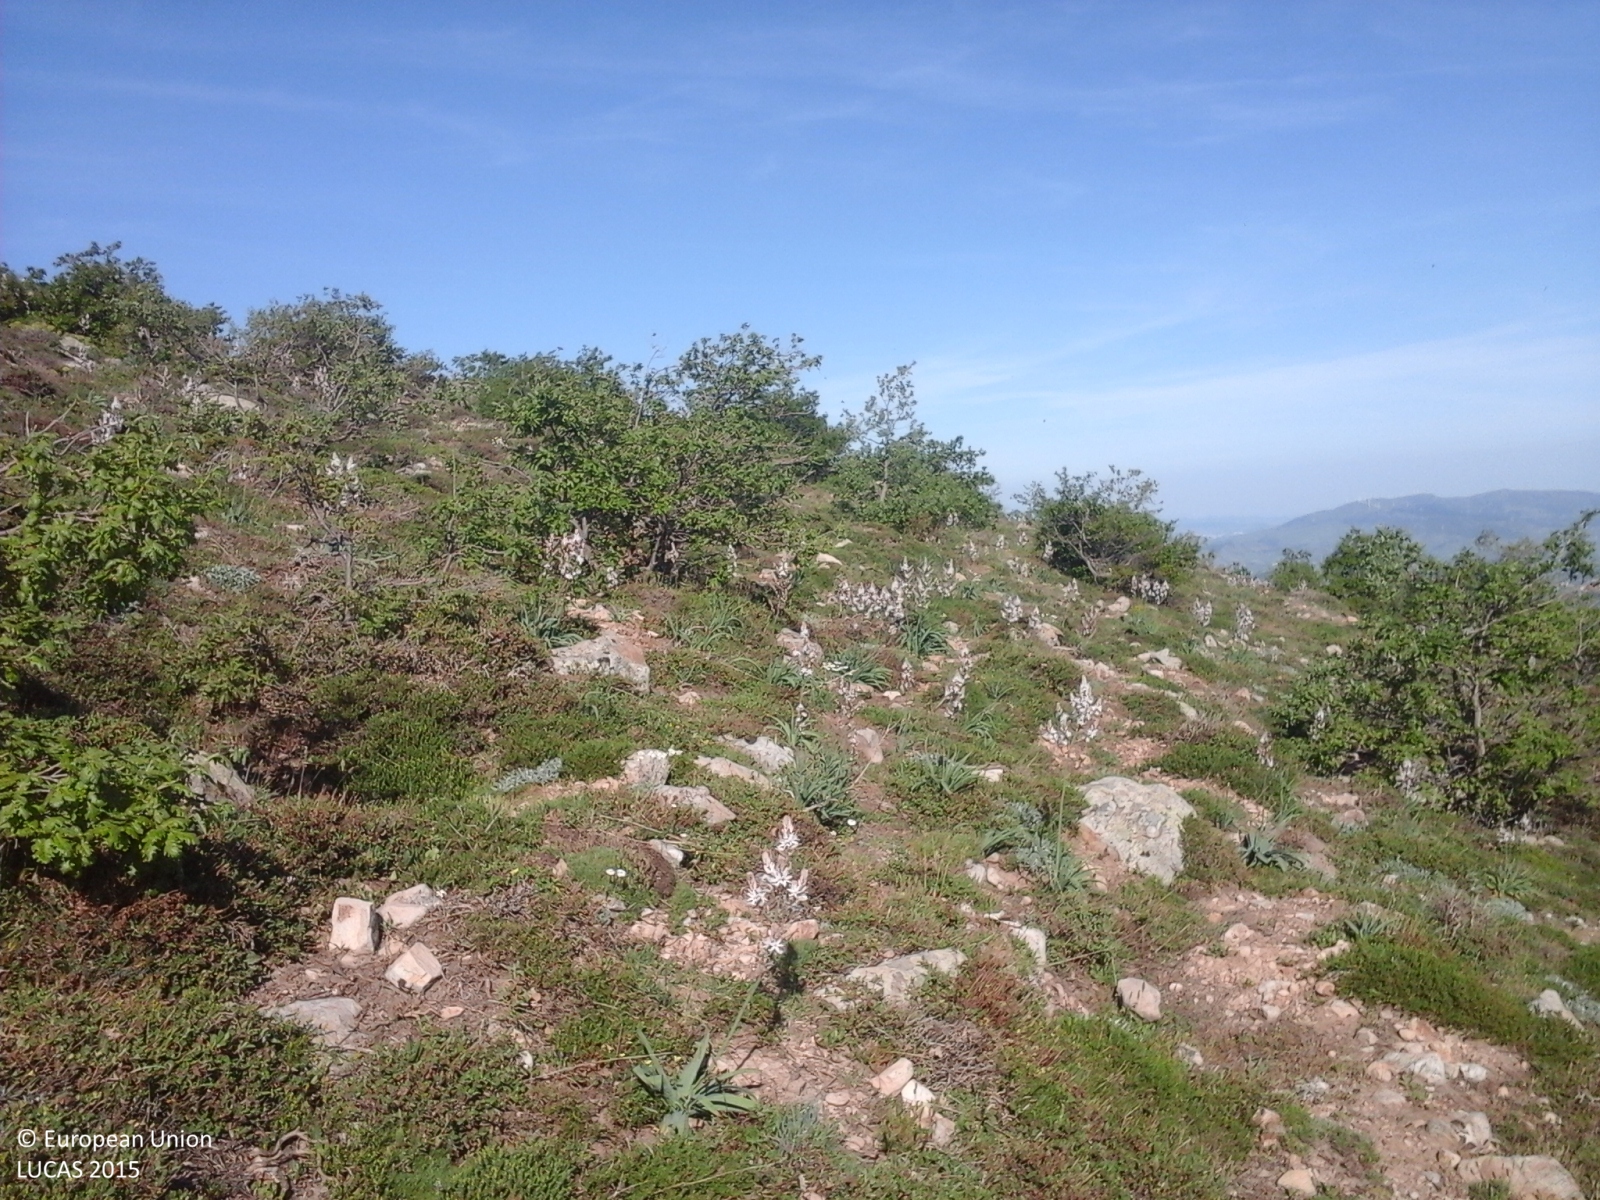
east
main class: Shrubland
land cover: Shrubland with sparse tree cover
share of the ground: > 75 %
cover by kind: shrubs 45 %, herbaceous plants 30 %, consolidated bare surface 15 %, broadleaved forest trees 5 %, unconsolidated bare surface 5 %
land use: Agriculture (excluding fallow land and kitchen gardens)
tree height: < 5 m
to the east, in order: Shrubland with sparse tree cover; Grassland without tree/shrub cover; Single bushes/trees; Grassland without tree/shrub cover; Shrubland with sparse tree cover
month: May
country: IT
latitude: 37.8248
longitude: 14.0497
